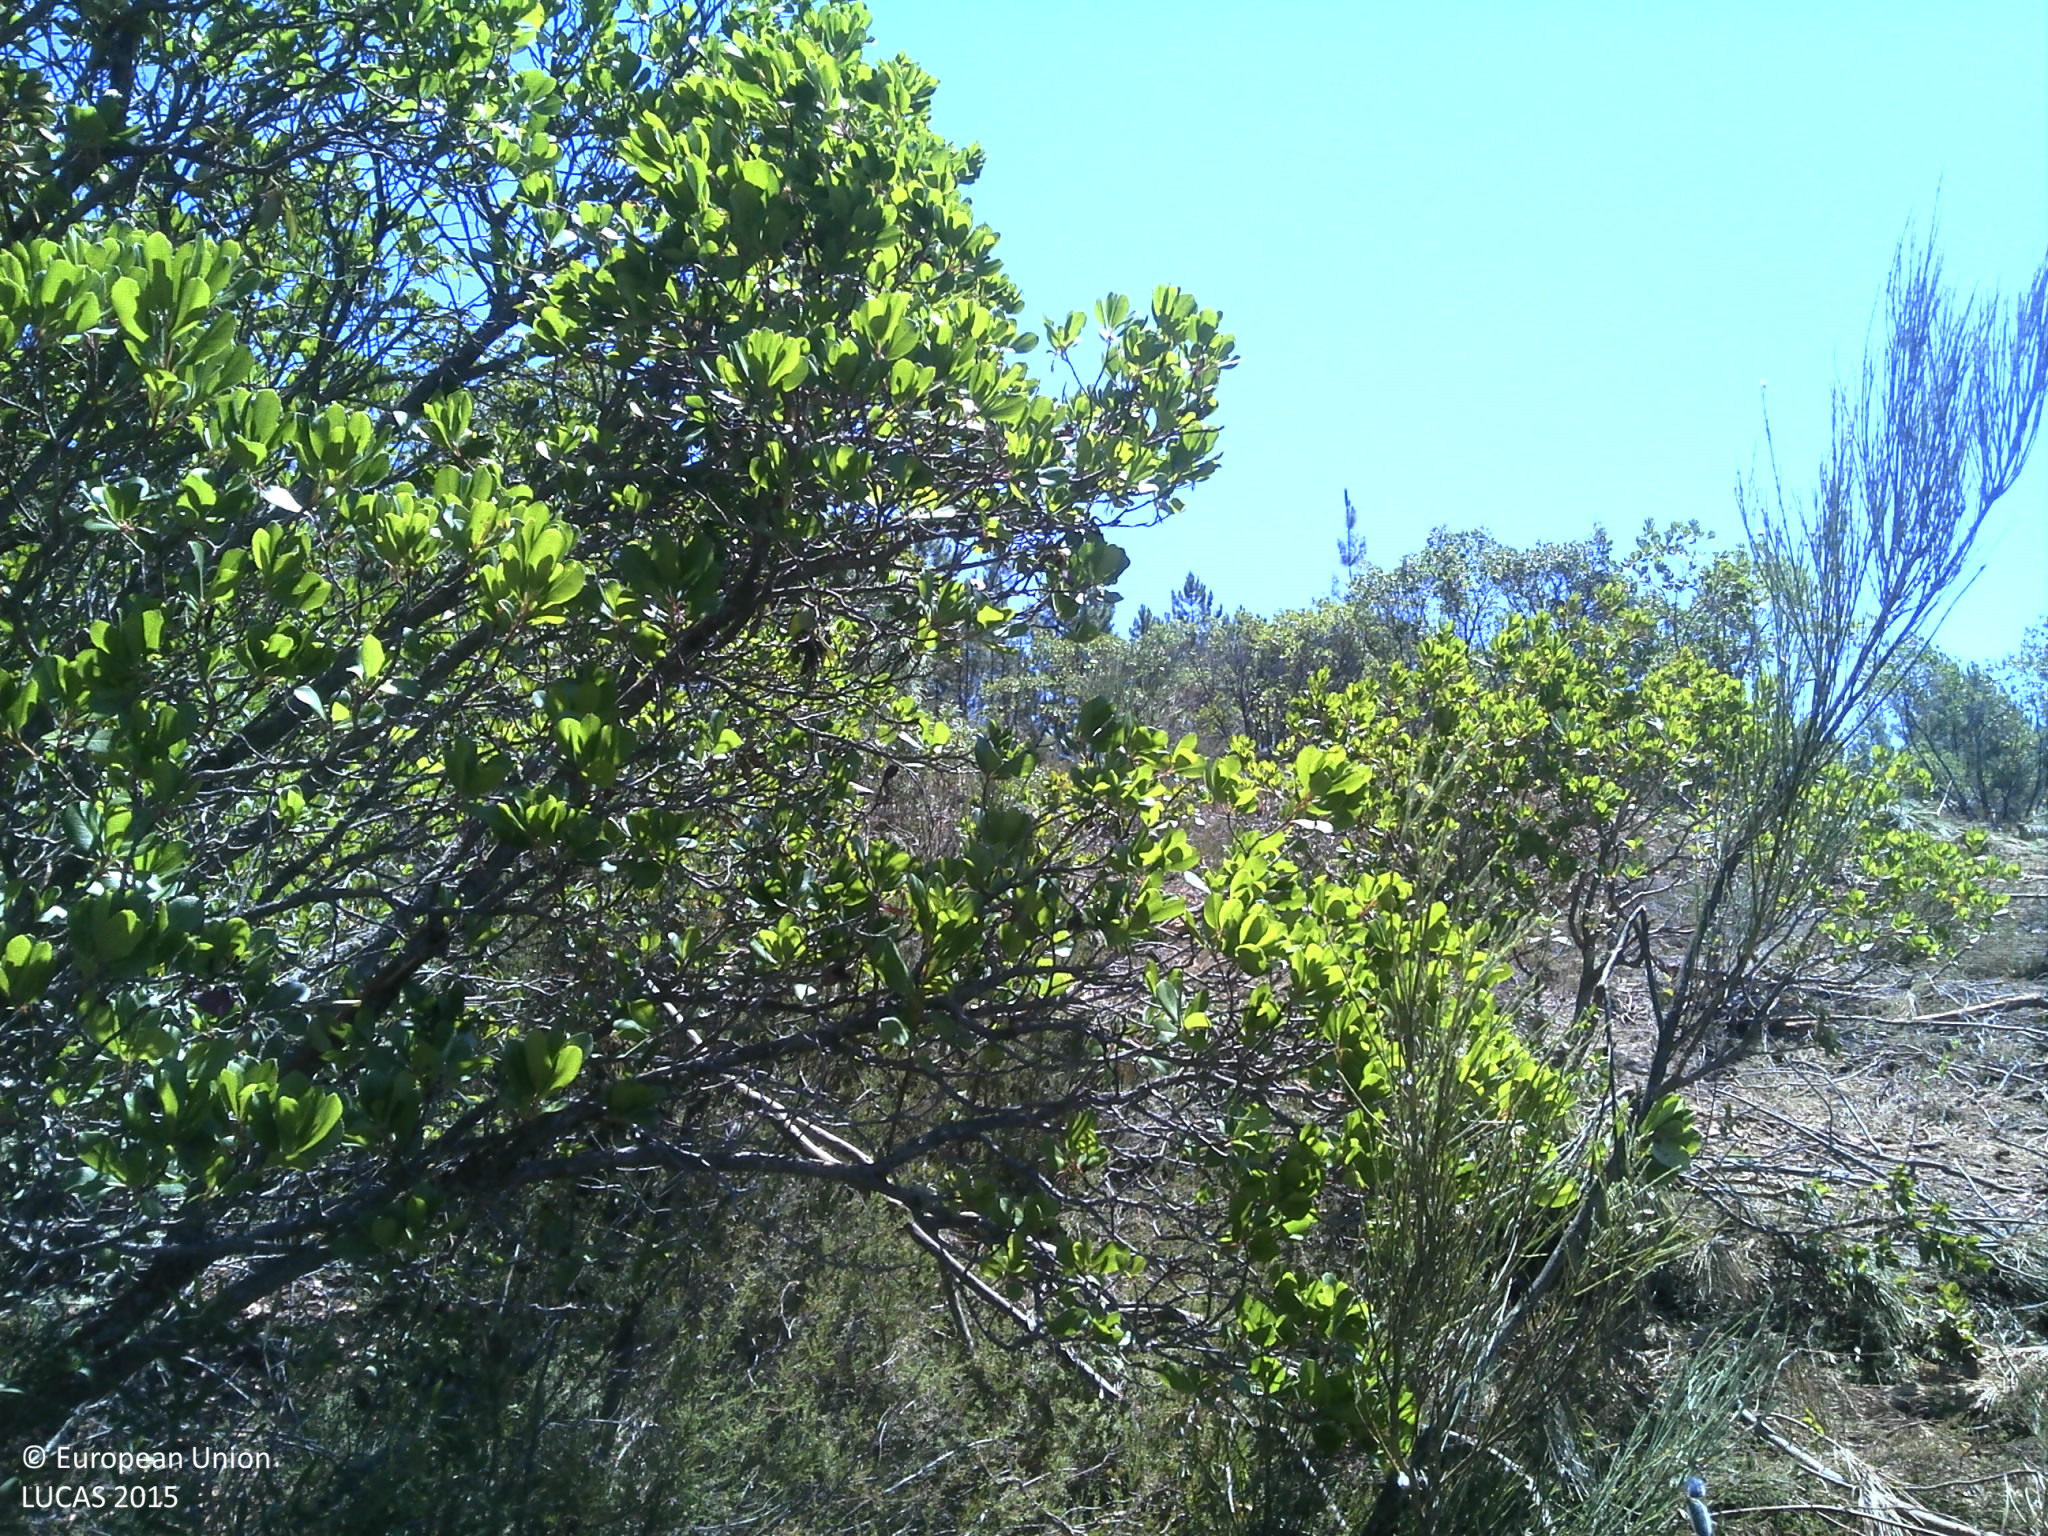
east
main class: Shrubland
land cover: Shrubland without tree cover
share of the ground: 50 - 75 %
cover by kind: shrubs 70 %, herbaceous plants 10 %, unconsolidated bare surface 10 %
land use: Forestry
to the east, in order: Shrubland without tree cover; Tracks; Shrubland without tree cover; Pine dominated coniferous woodland; Shrubland with sparse tree cover; Rivers and streams; Broadleaved woodland; Pine dominated coniferous woodland
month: July
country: PT
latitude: 40.1870
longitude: -7.7415
